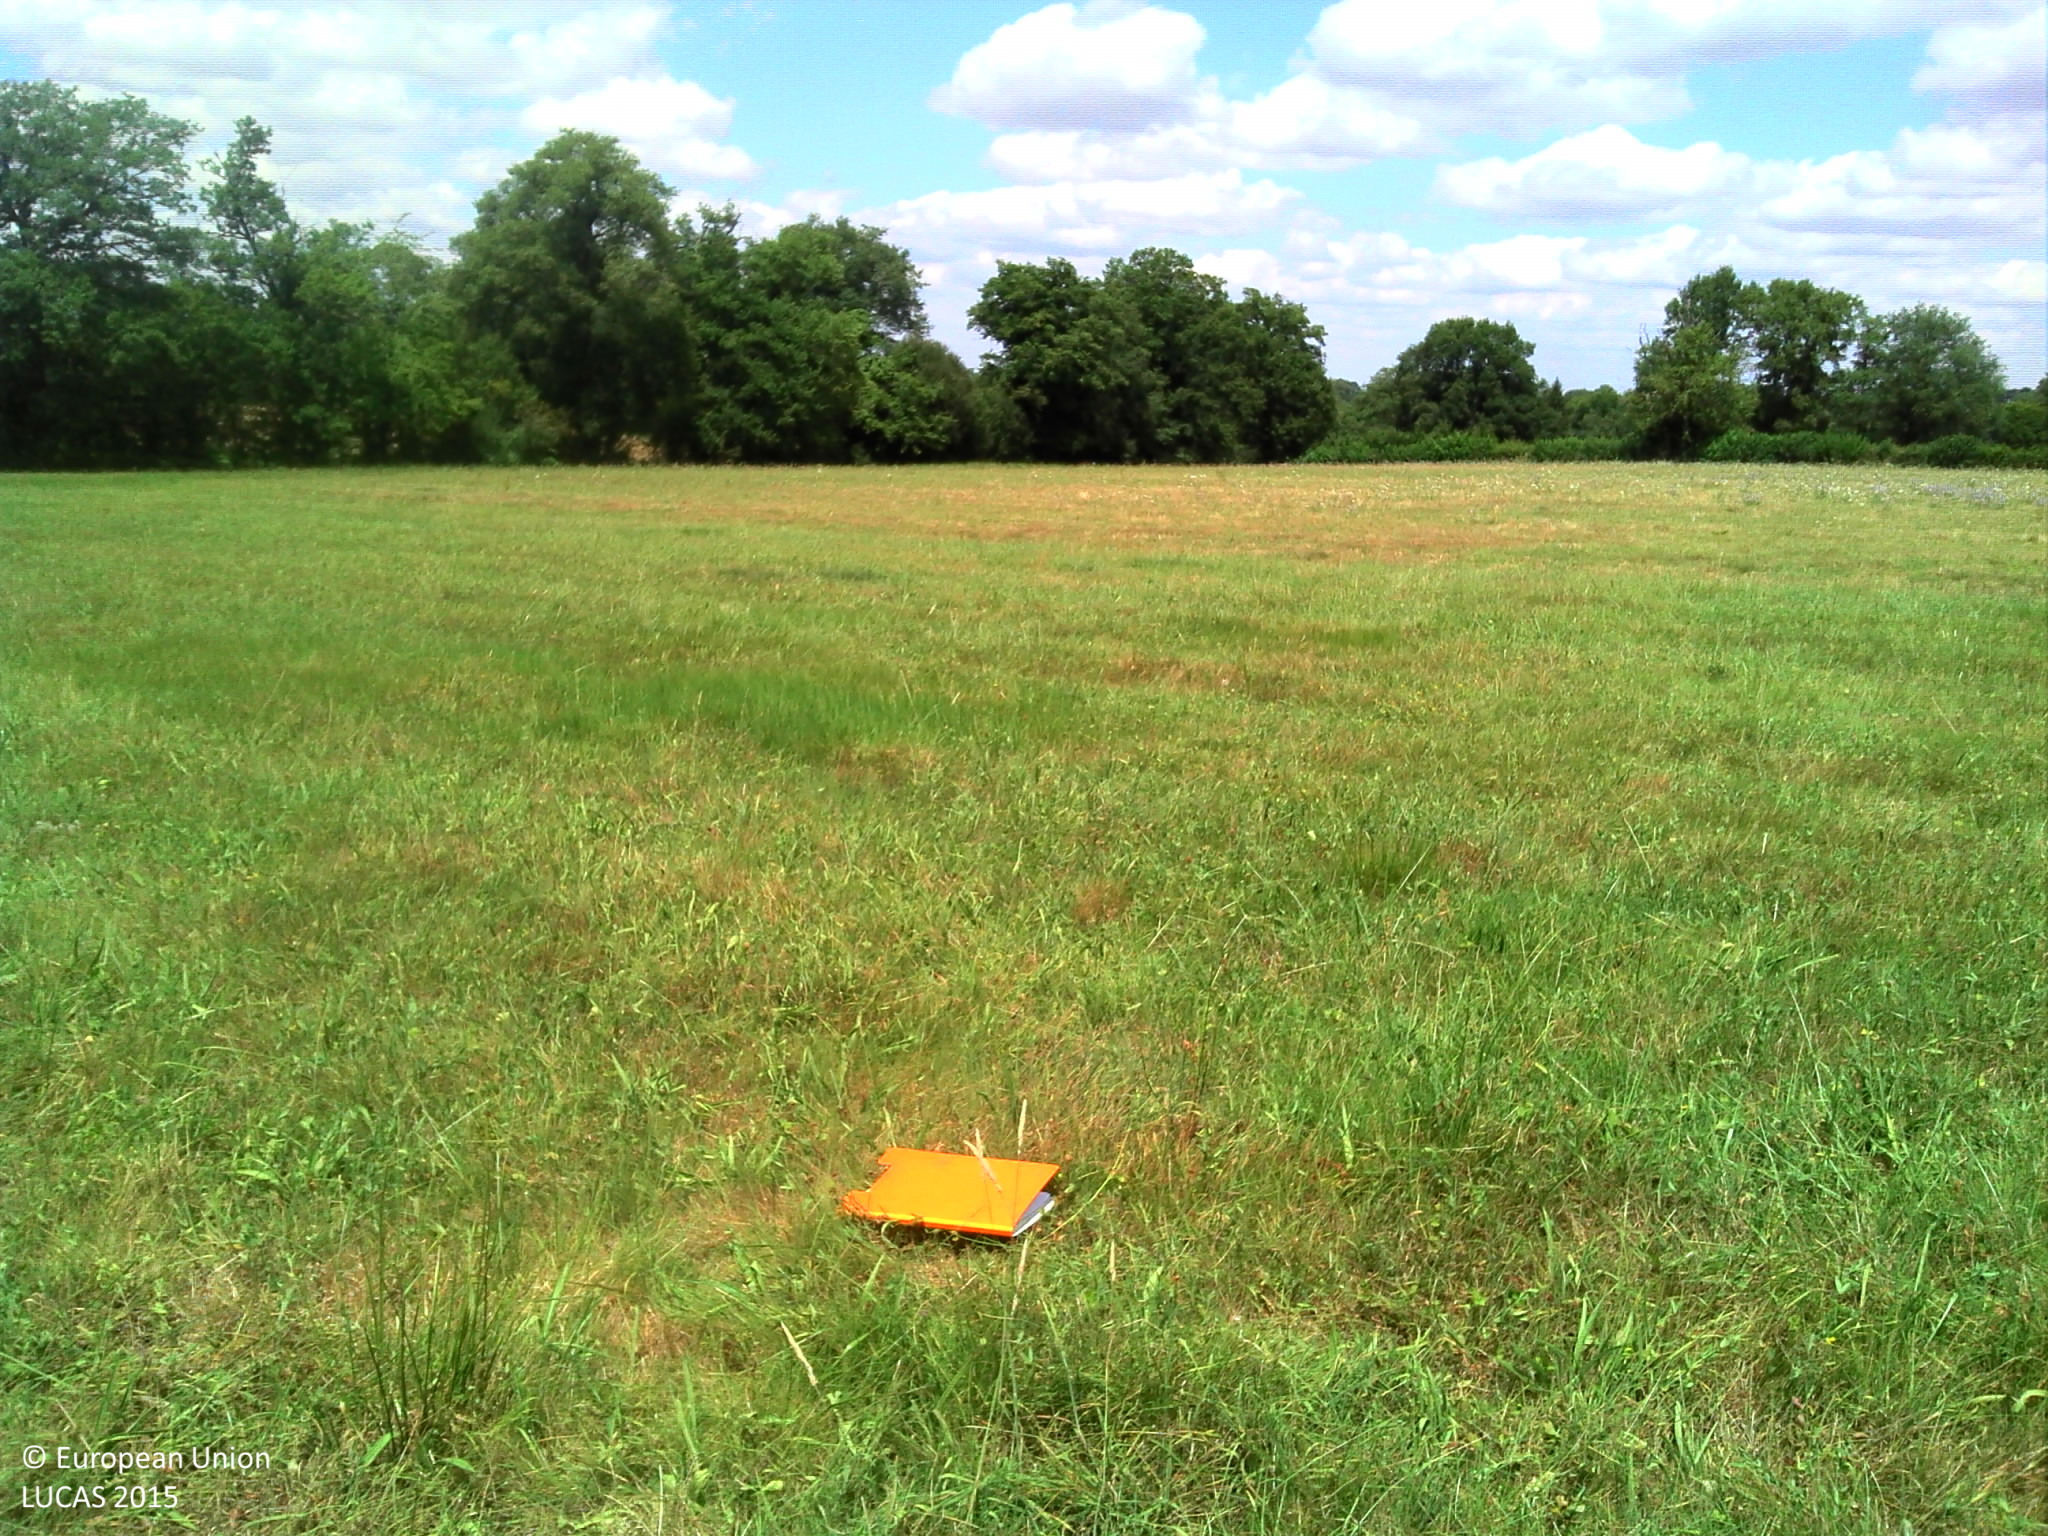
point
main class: Grassland
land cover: Grassland without tree/shrub cover
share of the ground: > 75 %
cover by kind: herbaceous plants 100 %
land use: Agriculture (excluding fallow land and kitchen gardens)
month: July
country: FR
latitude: 46.4637
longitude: 2.1938
